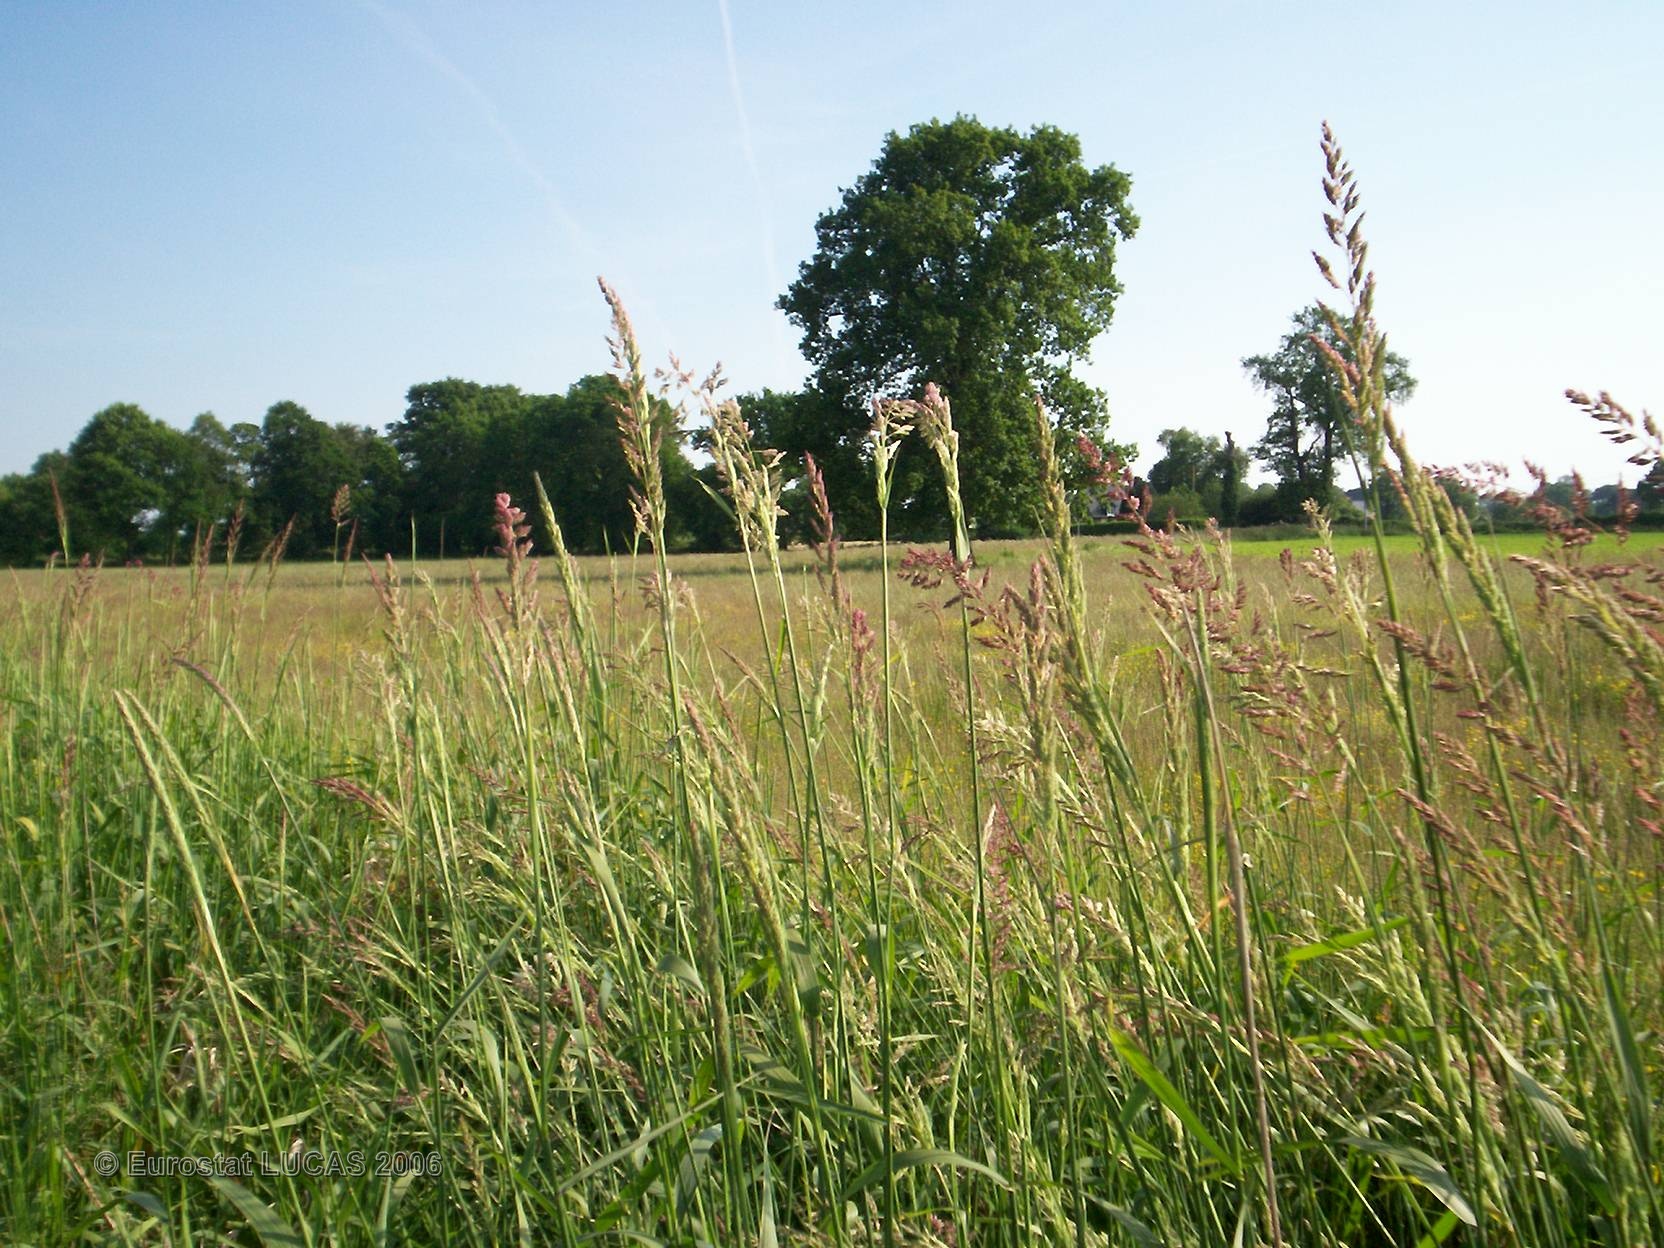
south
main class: Grassland
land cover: Grassland without tree/shrub cover
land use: Agriculture (excluding fallow land and kitchen gardens)
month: June
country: FR
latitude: 48.5421
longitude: -1.7123
